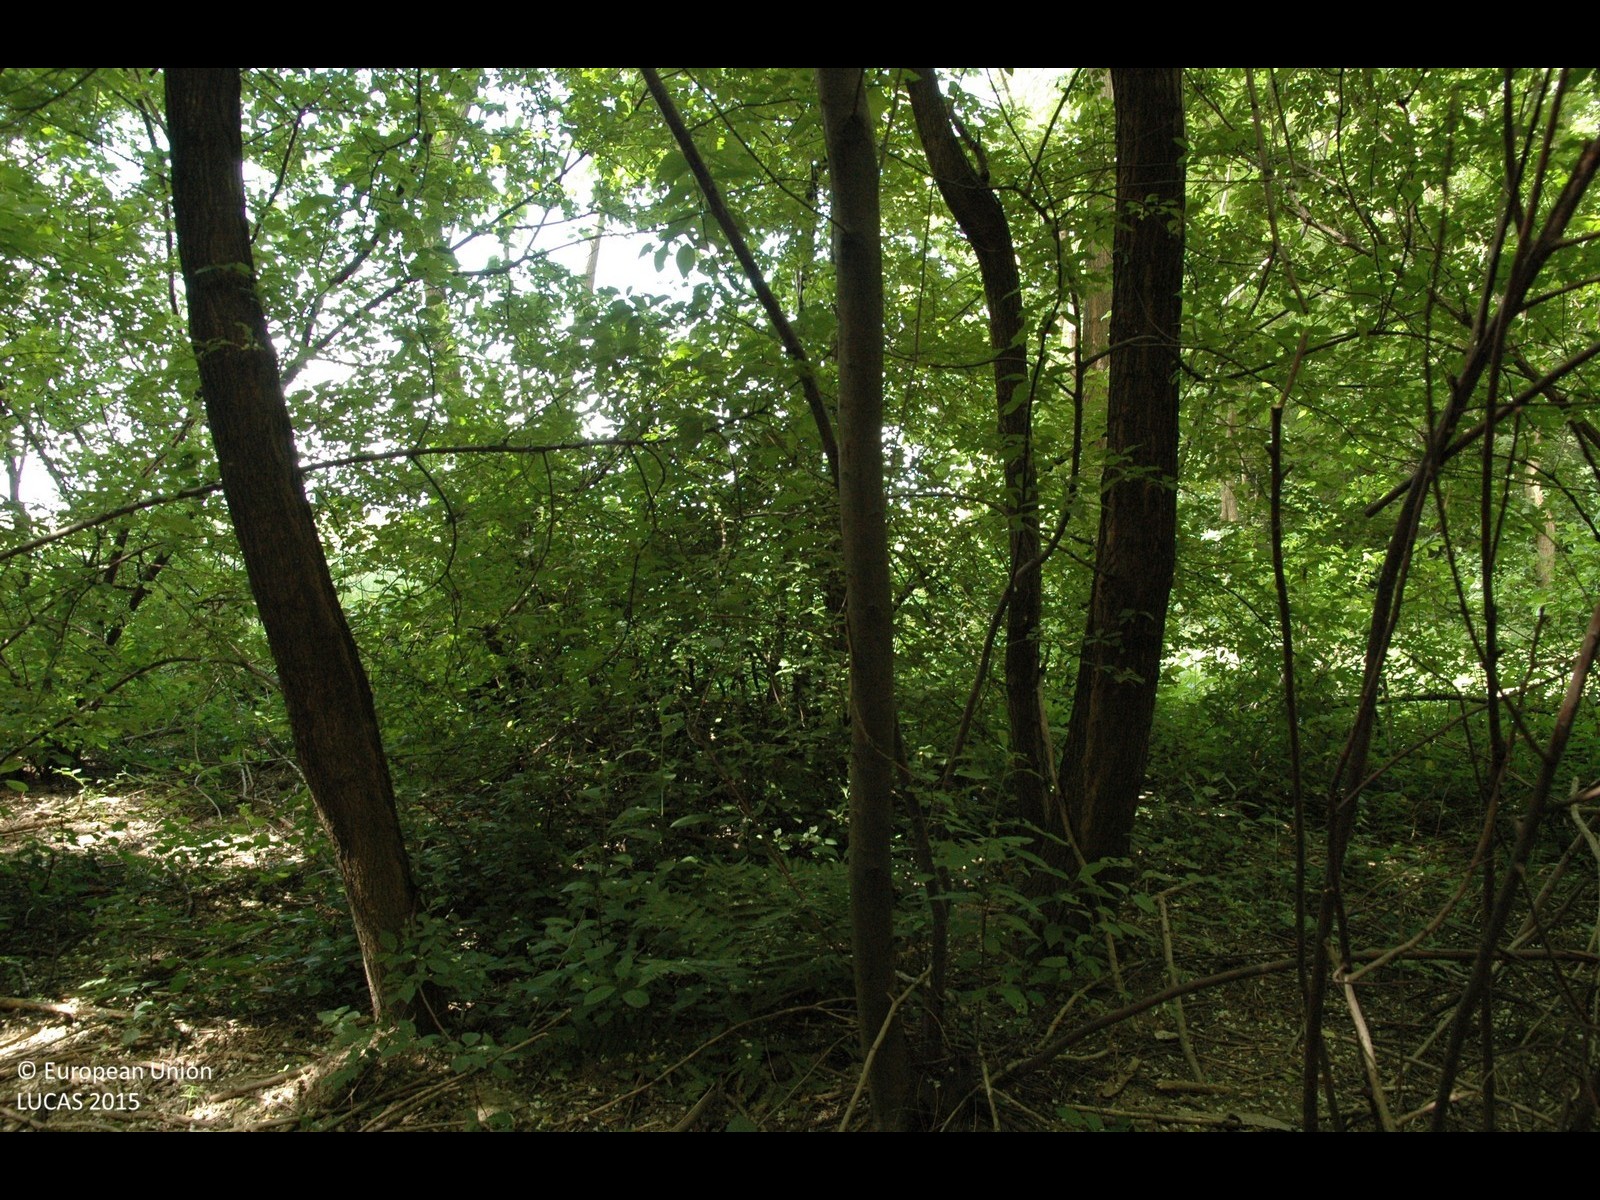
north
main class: Woodland
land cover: Broadleaved woodland
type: floodplain forest
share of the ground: > 75 %
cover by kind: broadleaved forest trees 90 %, shrubs 5 %, herbaceous plants 5 %
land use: Forestry
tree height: > 5 m
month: May
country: HR
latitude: 46.3024
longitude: 16.4271
